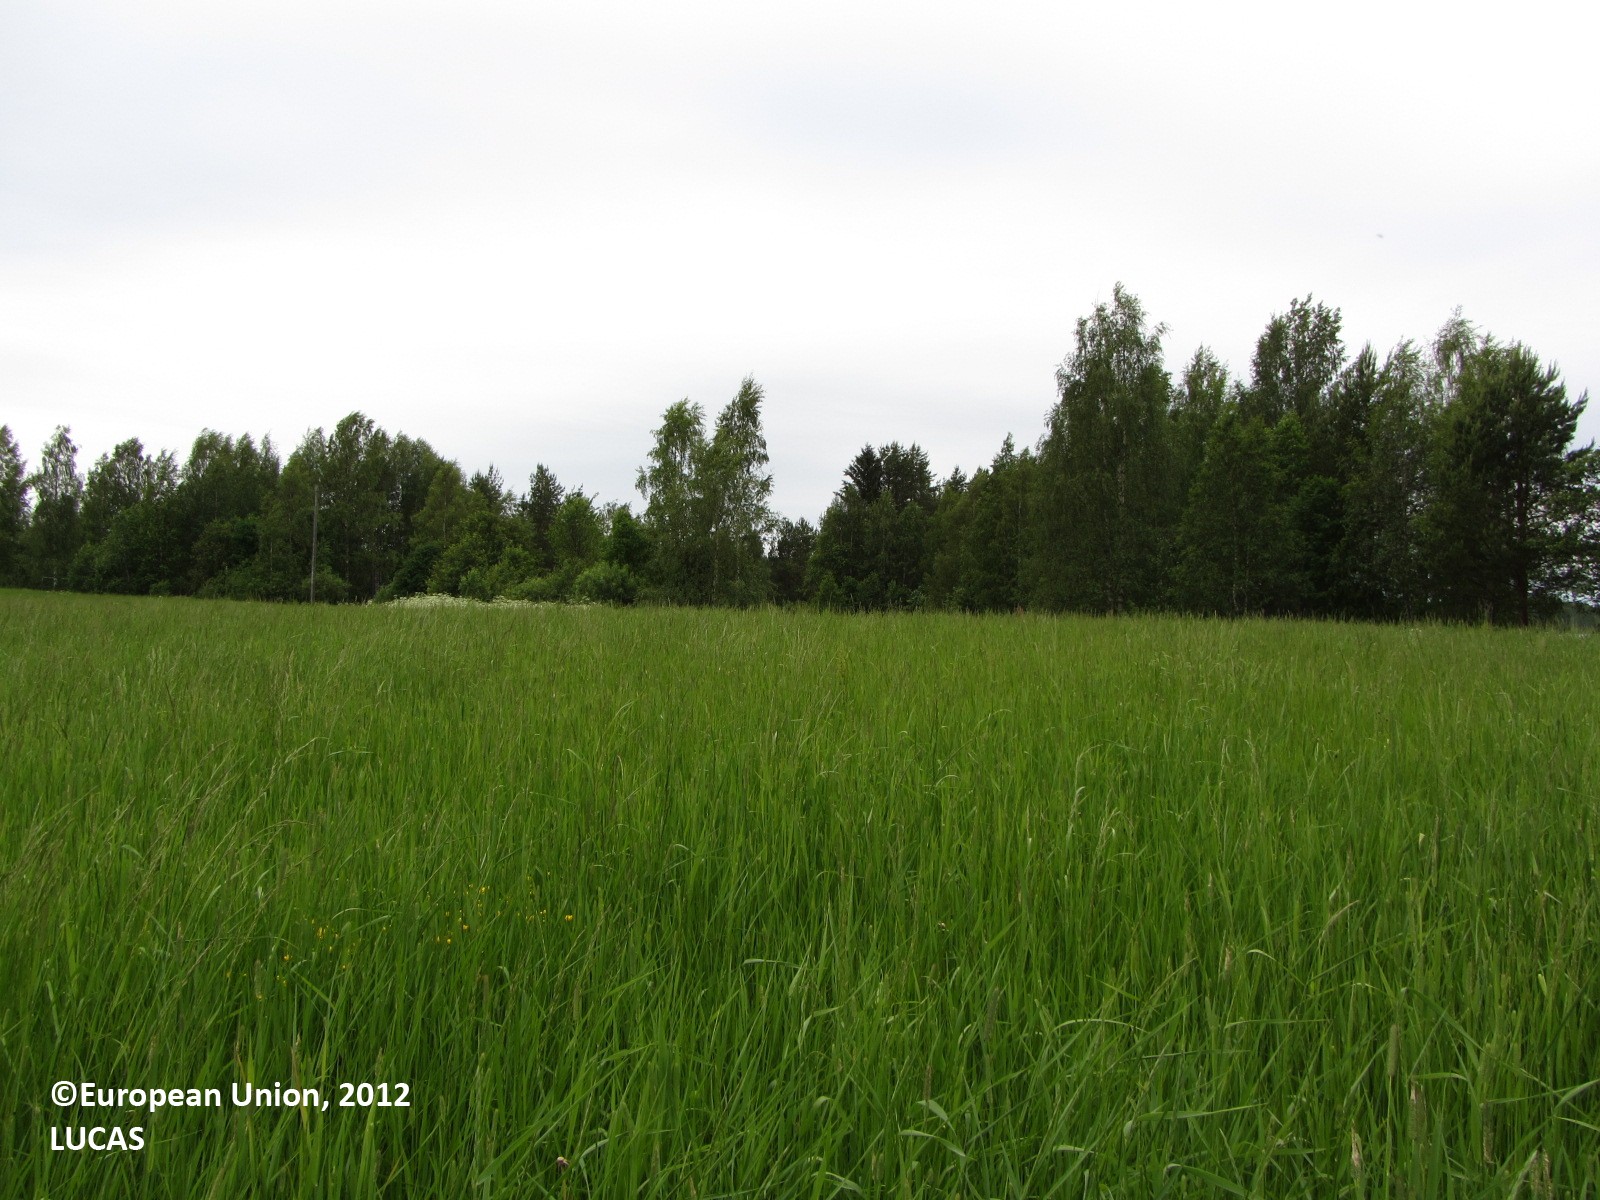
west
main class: Cropland
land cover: Temporary grasslands
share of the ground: > 75 %
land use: Agriculture (excluding fallow land and kitchen gardens)
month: June
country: FI
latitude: 62.6972
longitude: 25.0488
